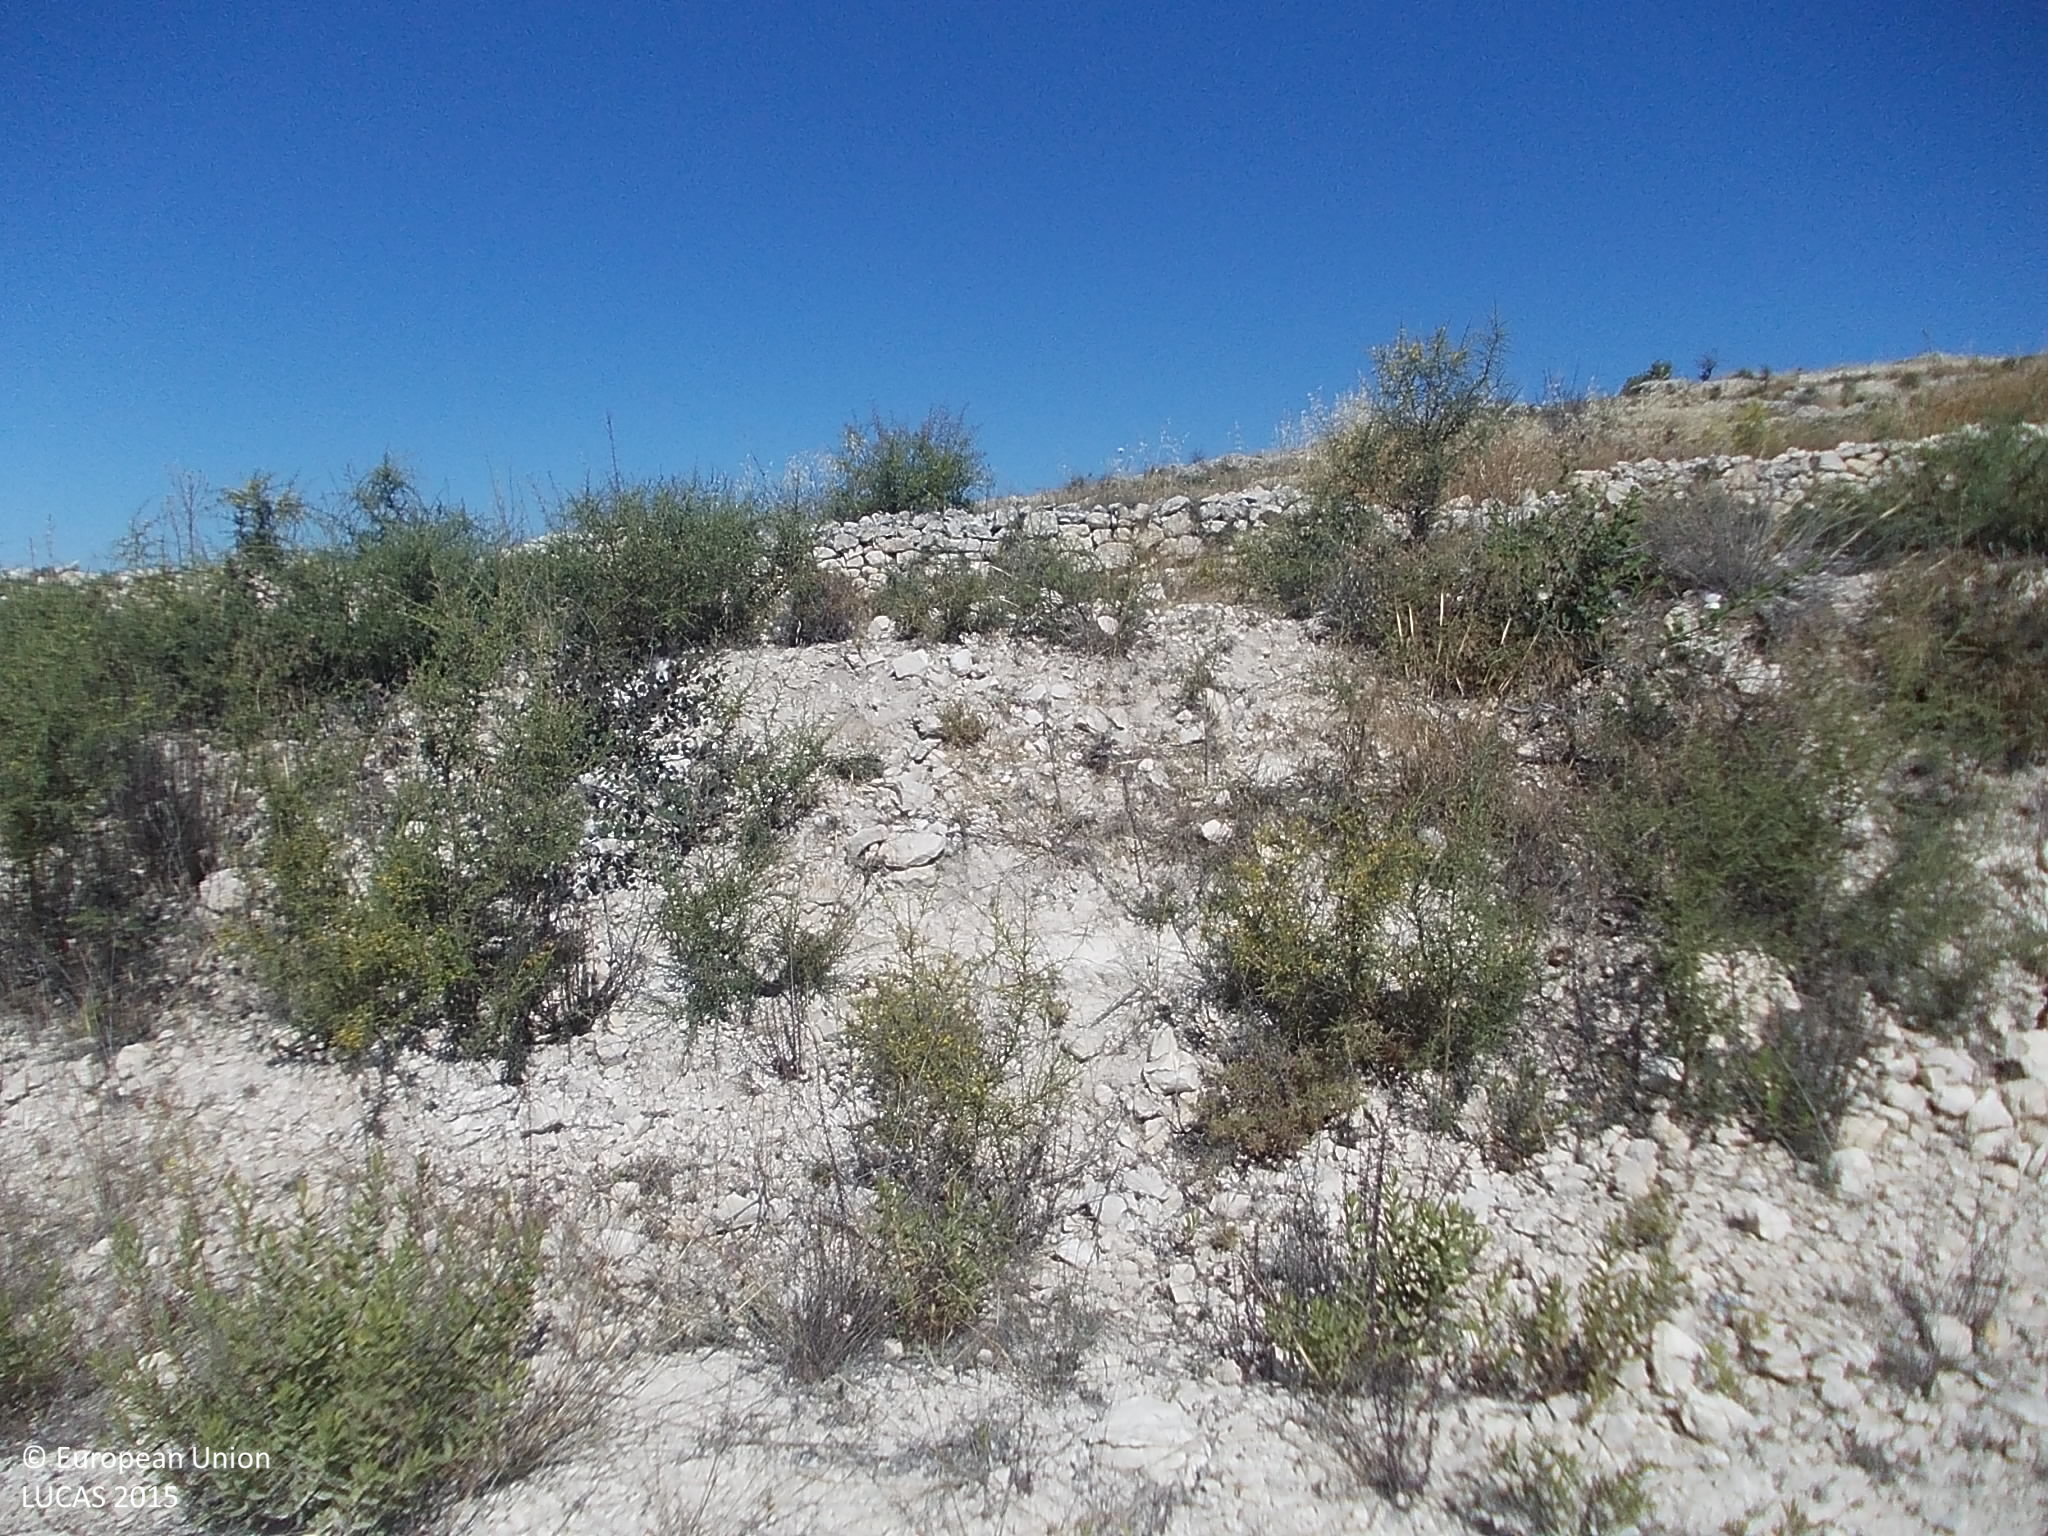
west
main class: Cropland
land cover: Vineyards
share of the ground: 10 - 25 %
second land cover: Rocks and stones
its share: > 75 %
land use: Agriculture (excluding fallow land and kitchen gardens)
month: July
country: CY
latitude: 34.8531
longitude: 32.7673
